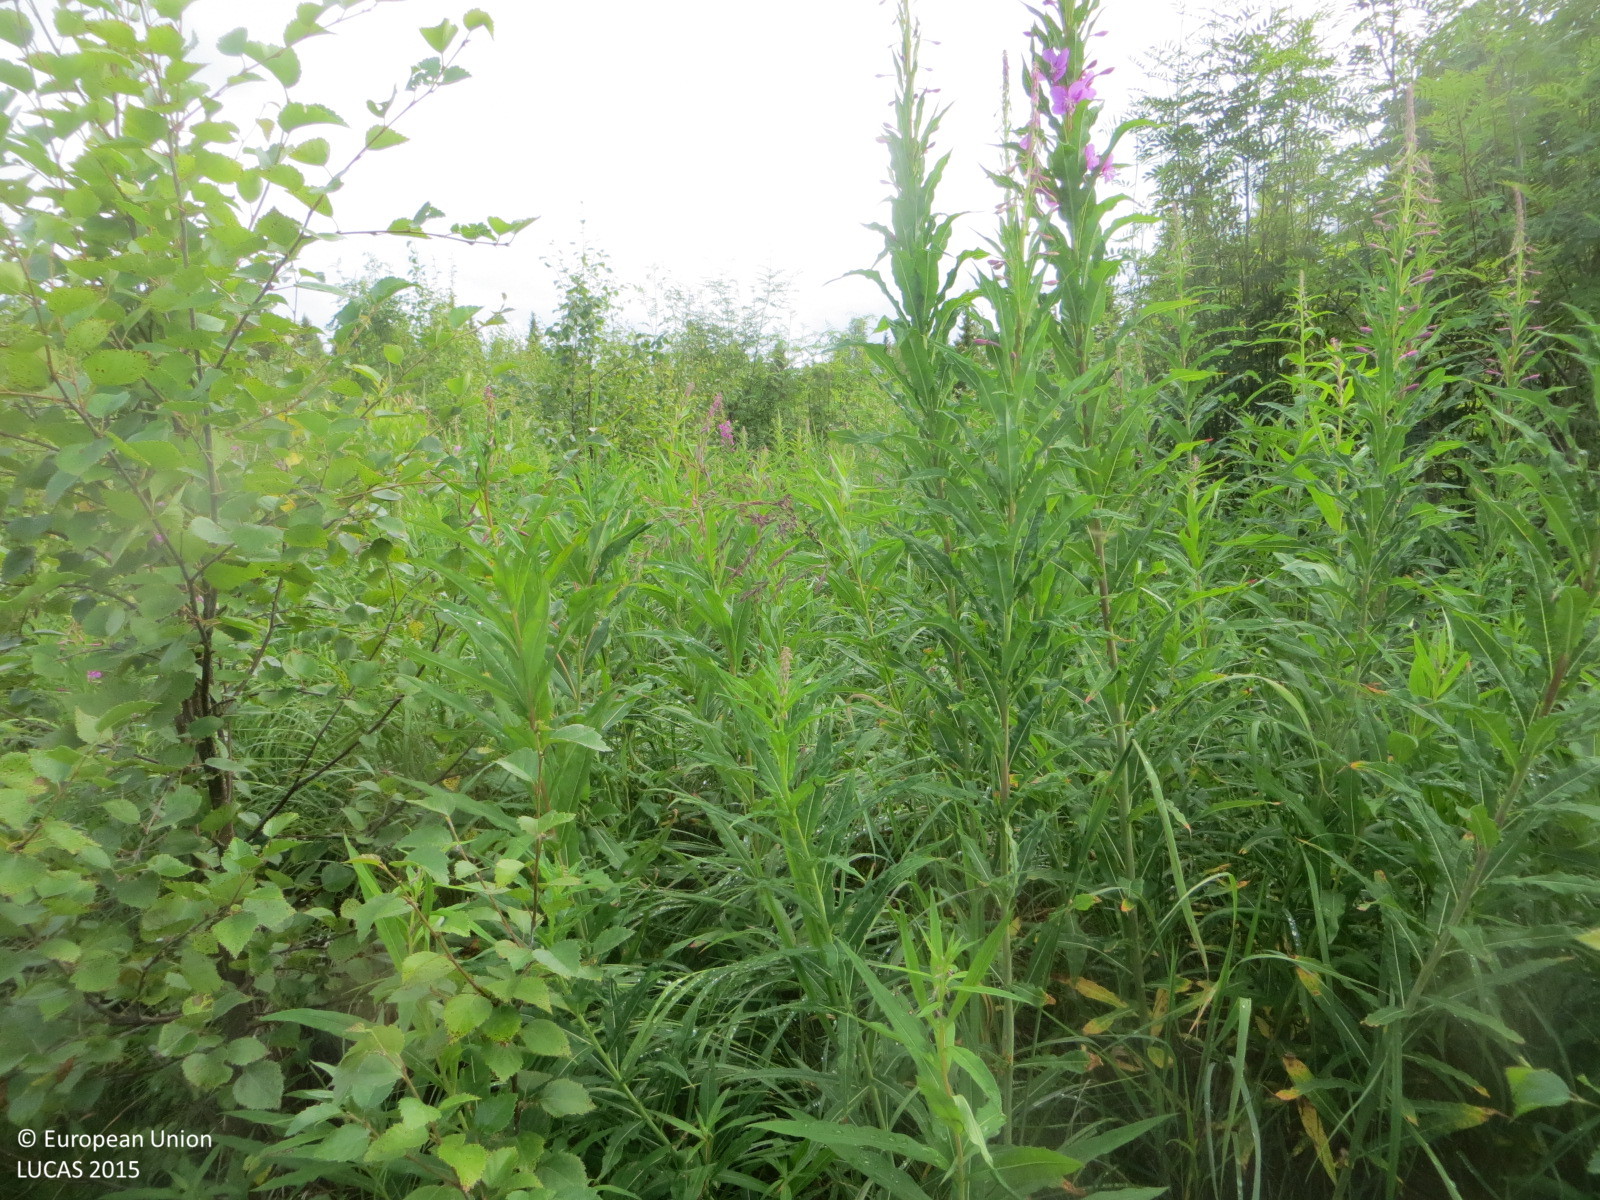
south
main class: Woodland
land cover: Broadleaved woodland
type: boreal forest
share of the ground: > 75 %
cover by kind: broadleaved forest trees 75 %, herbaceous plants 15 %, shrubs 10 %
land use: Forestry
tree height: < 5 m
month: July
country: FI
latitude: 65.9955
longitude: 24.3008
